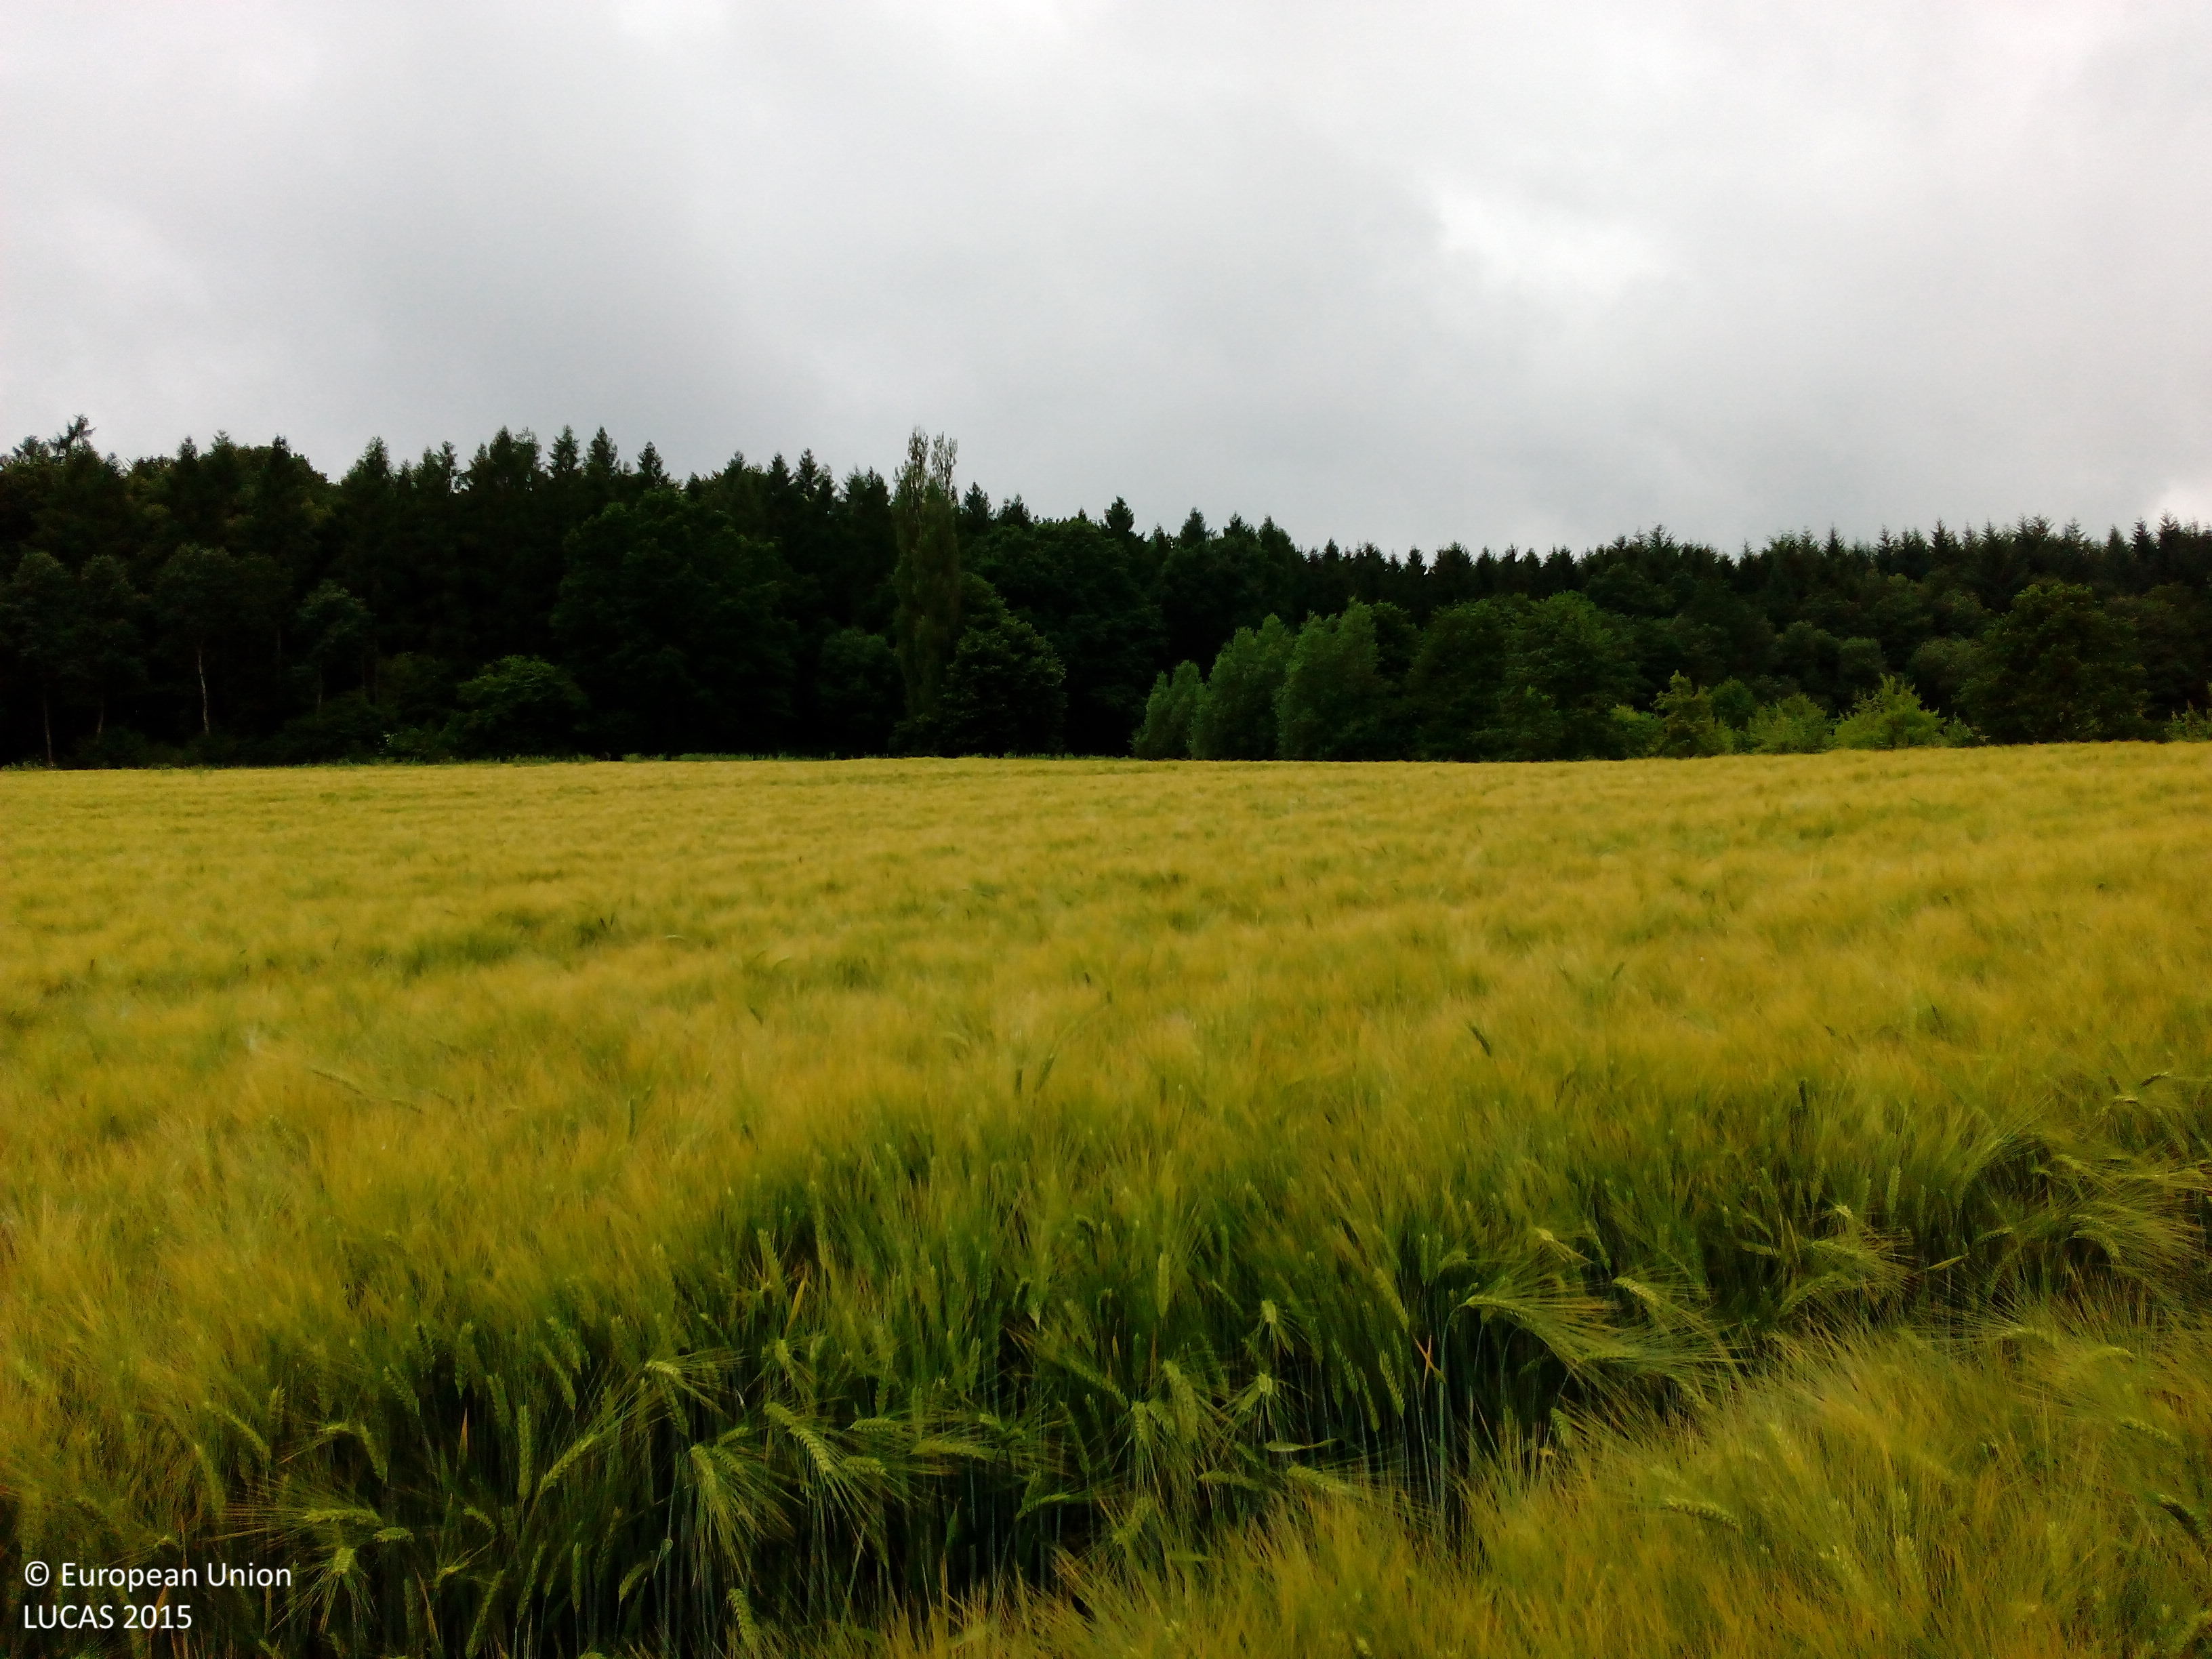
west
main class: Cropland
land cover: Barley
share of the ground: > 75 %
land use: Agriculture (excluding fallow land and kitchen gardens)
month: June
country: DE
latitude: 51.6399
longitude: 9.6100
